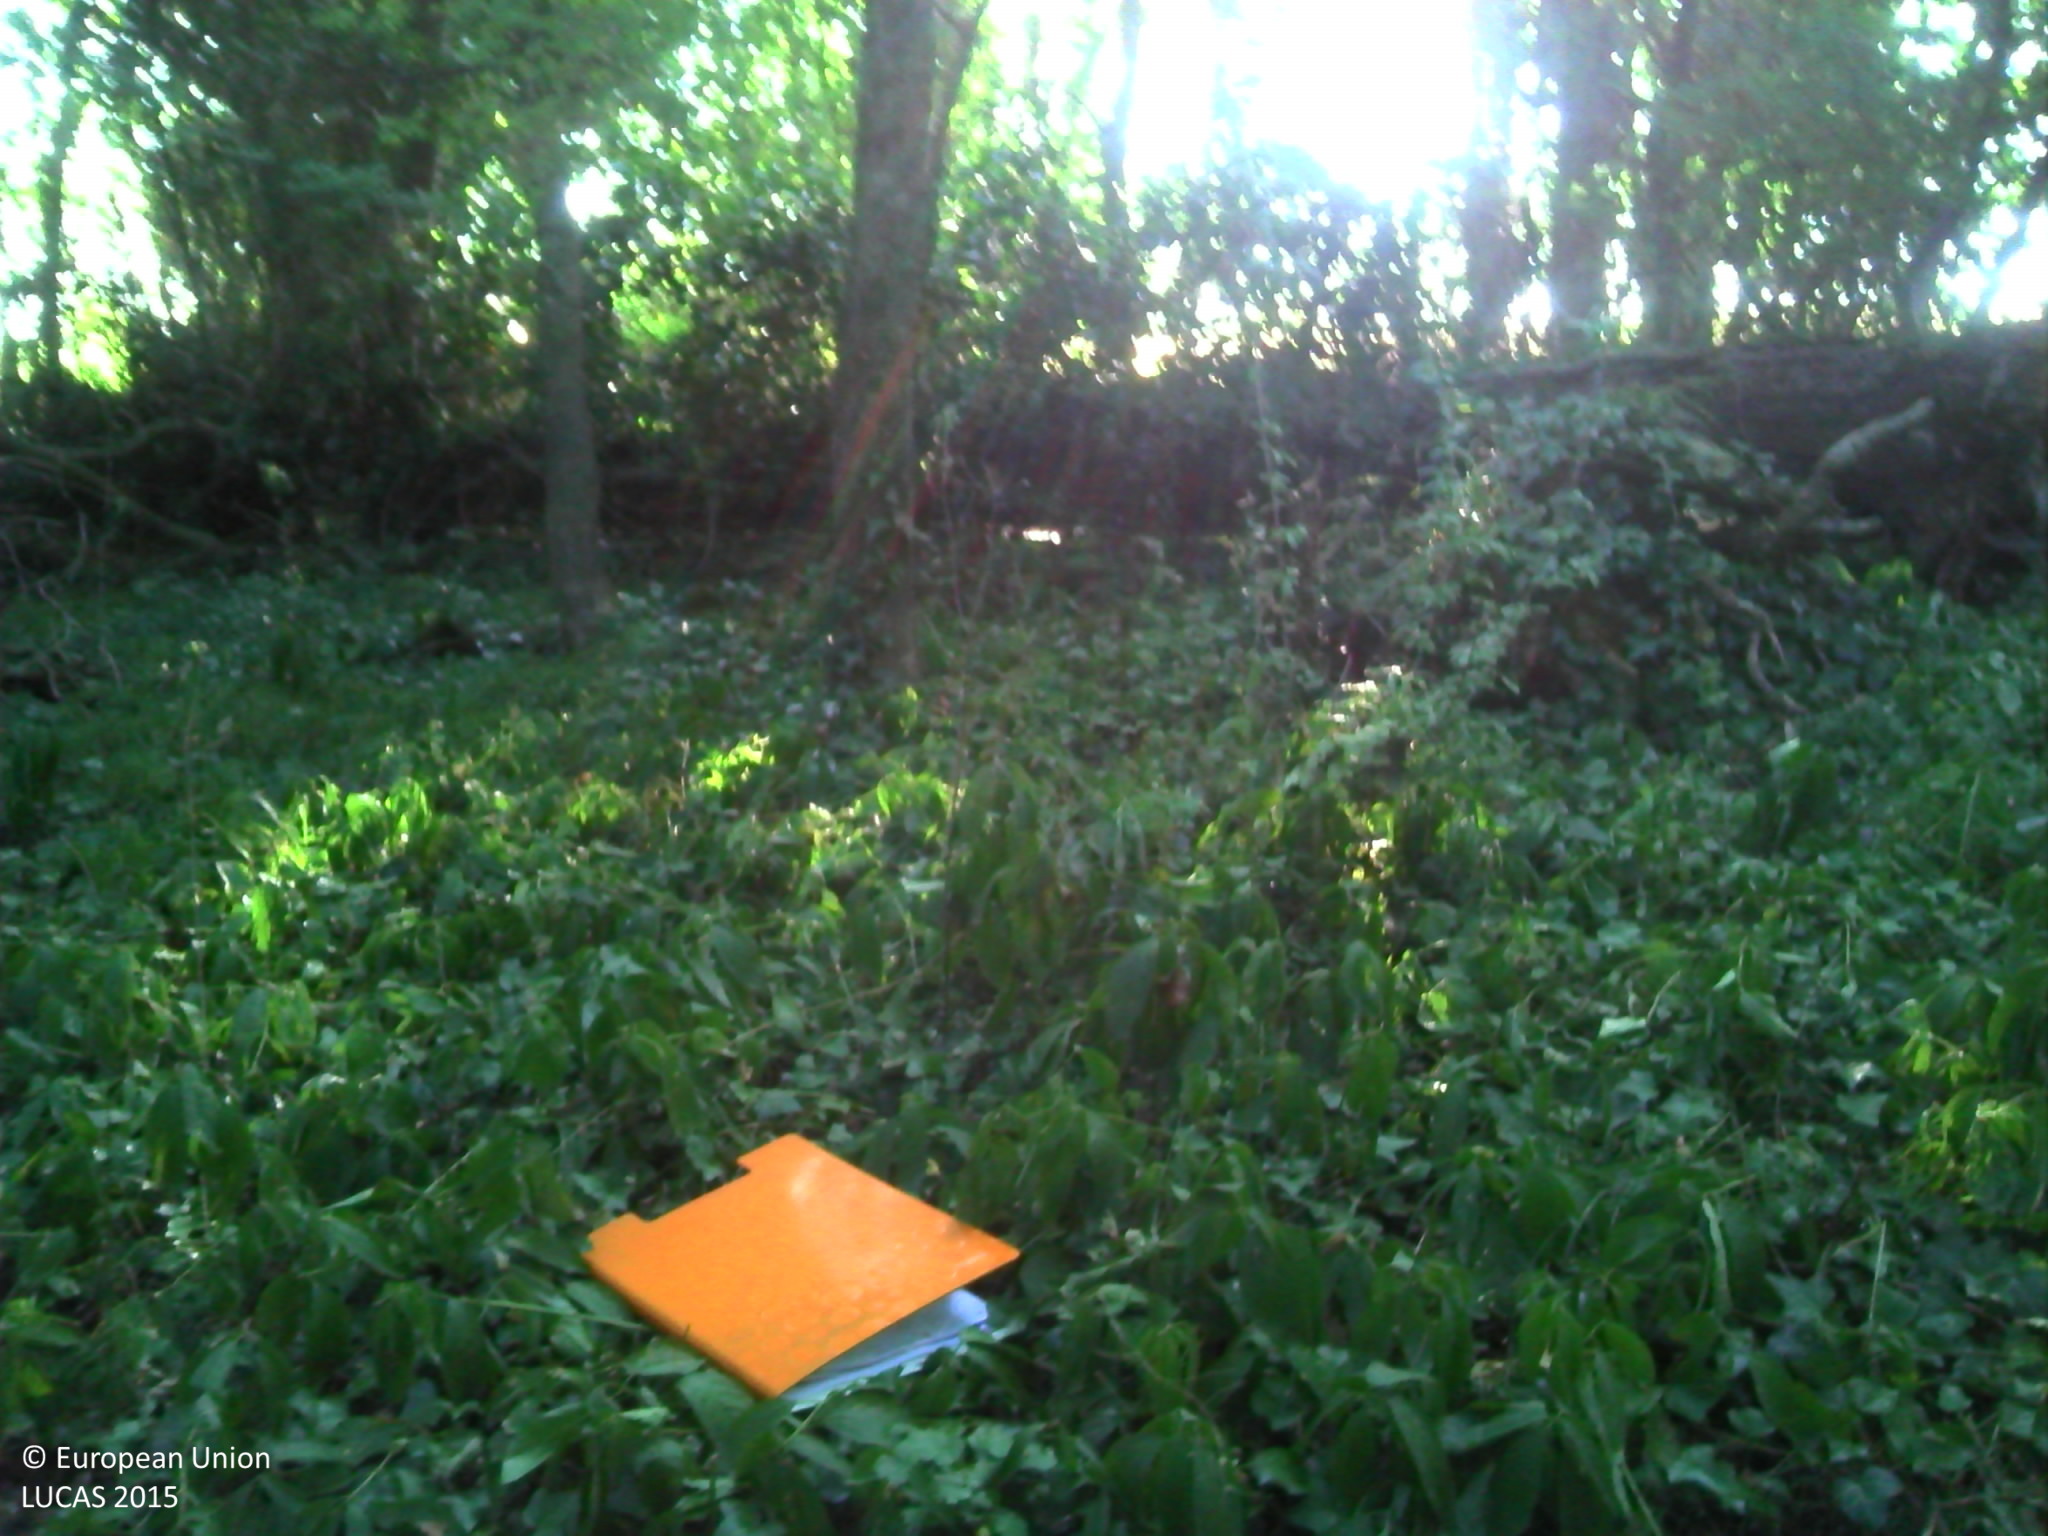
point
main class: Woodland
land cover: Broadleaved woodland
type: mesophytic deciduous forest
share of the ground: > 75 %
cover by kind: broadleaved forest trees 100 %
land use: Semi-natural and natural areas not in use
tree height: > 5 m
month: July
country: FR
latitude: 46.8439
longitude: 3.2701
